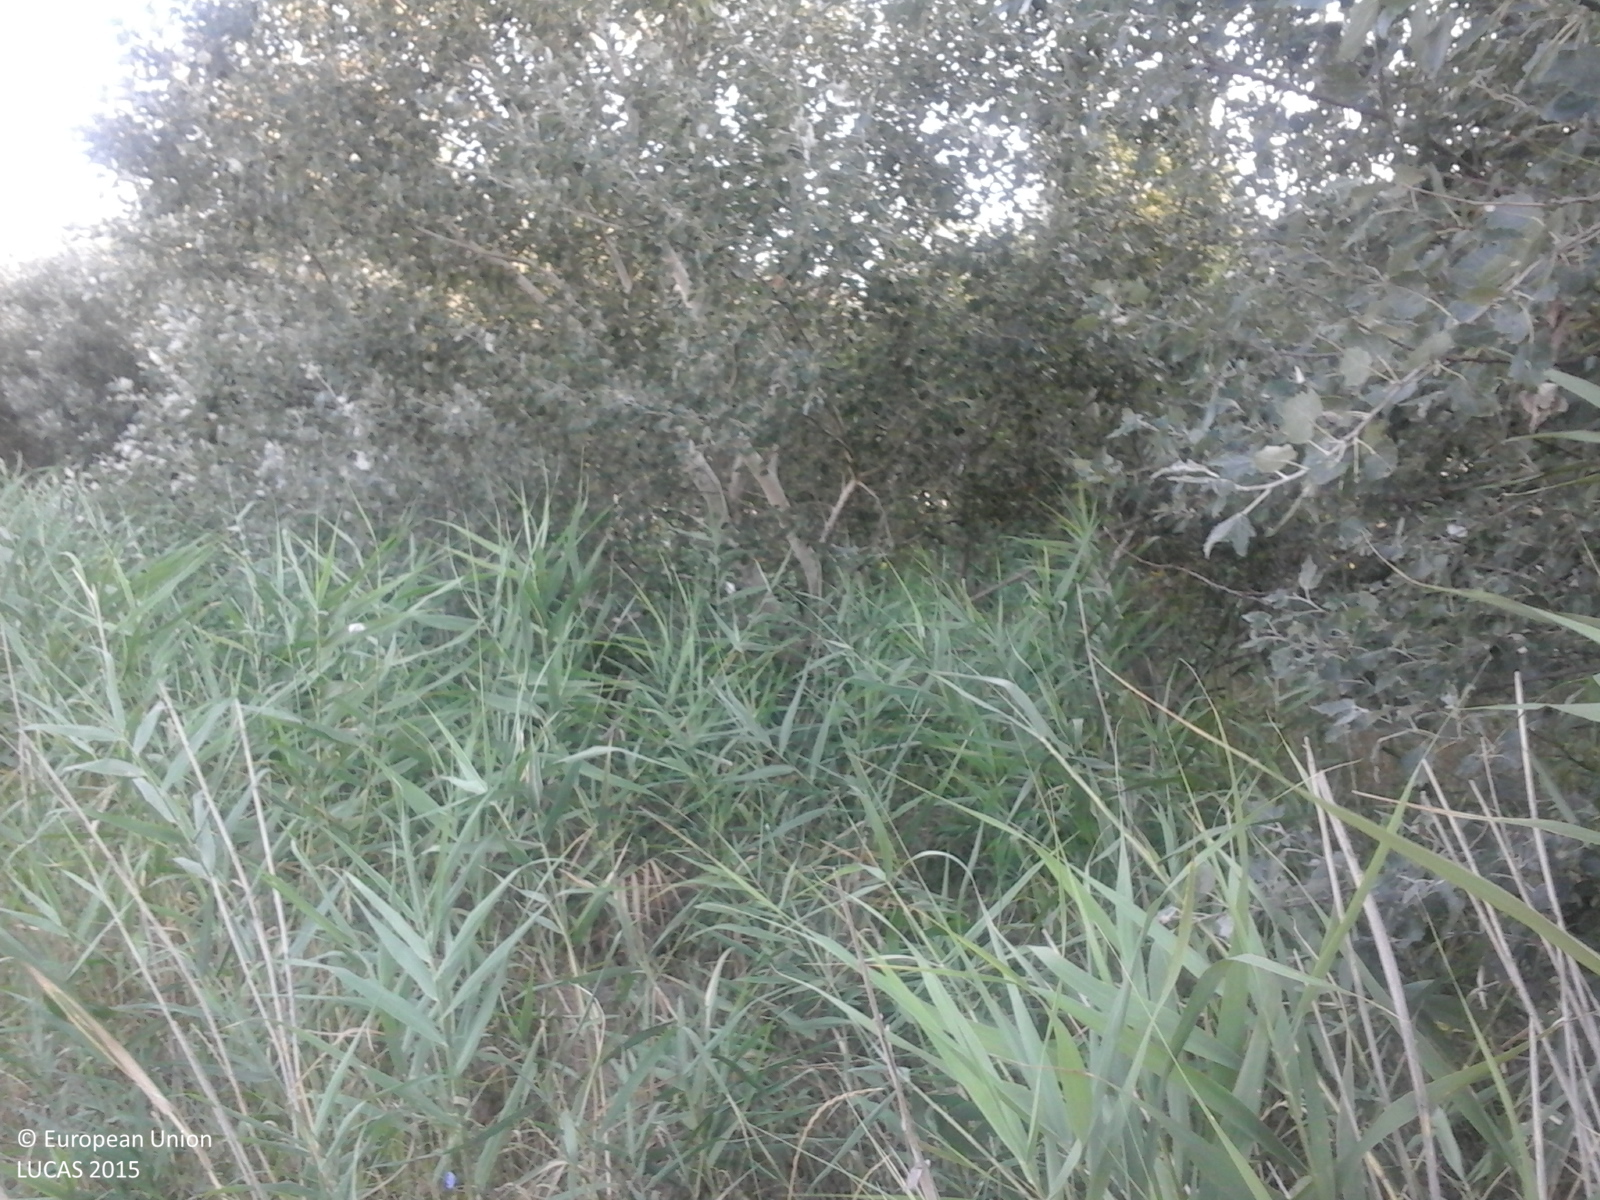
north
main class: Woodland
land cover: Broadleaved woodland
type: floodplain forest
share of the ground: > 75 %
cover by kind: broadleaved forest trees 100 %
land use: Forestry
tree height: > 5 m
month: July
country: RO
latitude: 44.5795
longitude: 27.0707
